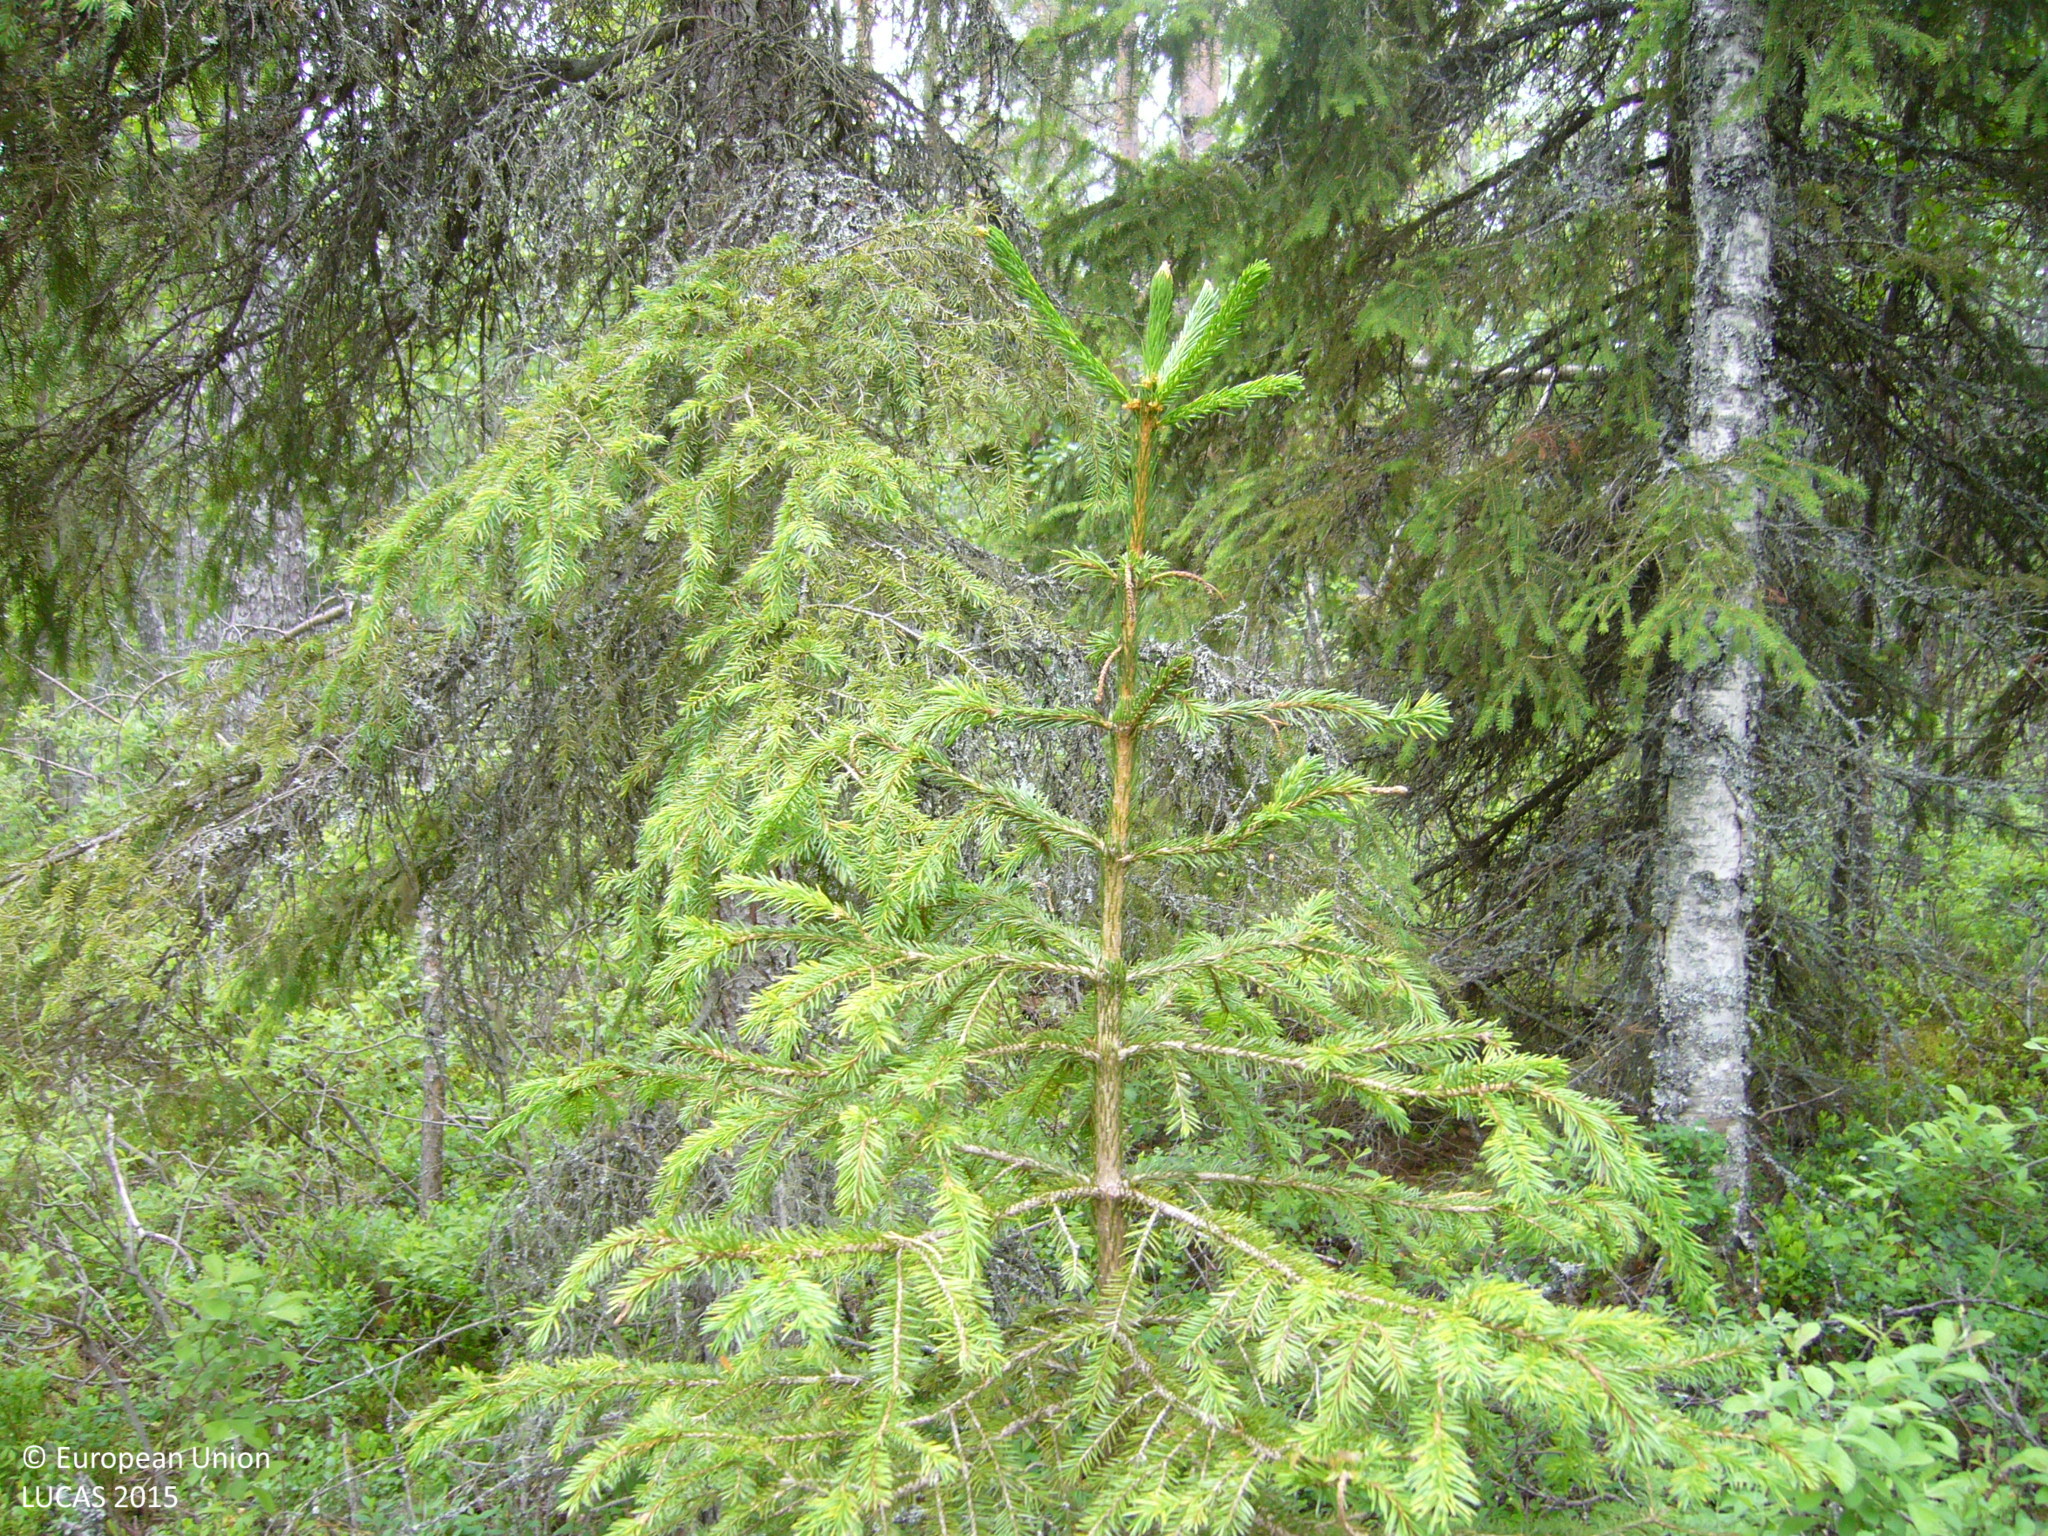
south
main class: Woodland
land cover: Pine dominated mixed woodland
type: boreal forest
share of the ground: 50 - 75 %
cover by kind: coniferous forest trees 40 %, shrubs 35 %, broadleaved forest trees 25 %
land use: Forestry
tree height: > 5 m
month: July
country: FI
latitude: 63.4338
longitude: 25.9662
